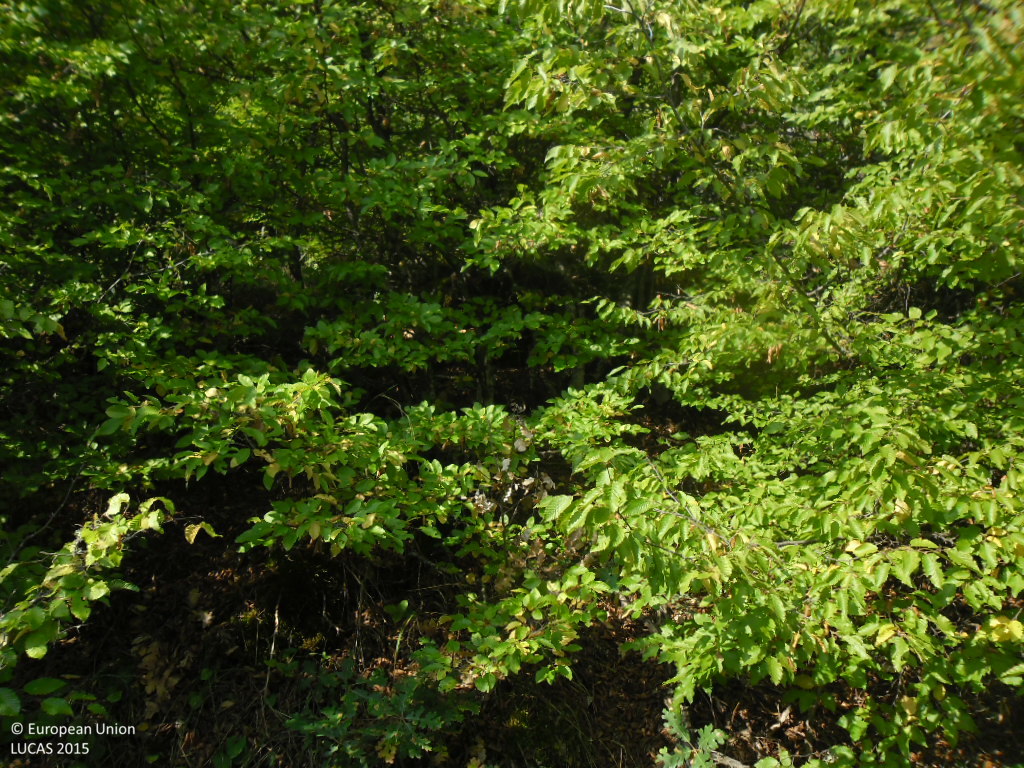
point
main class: Woodland
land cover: Broadleaved woodland
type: mesophytic deciduous forest
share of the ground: > 75 %
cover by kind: broadleaved forest trees 90 %, unconsolidated bare surface 10 %
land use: Forestry
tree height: < 5 m
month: September
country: BG
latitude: 41.9301
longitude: 22.9371
